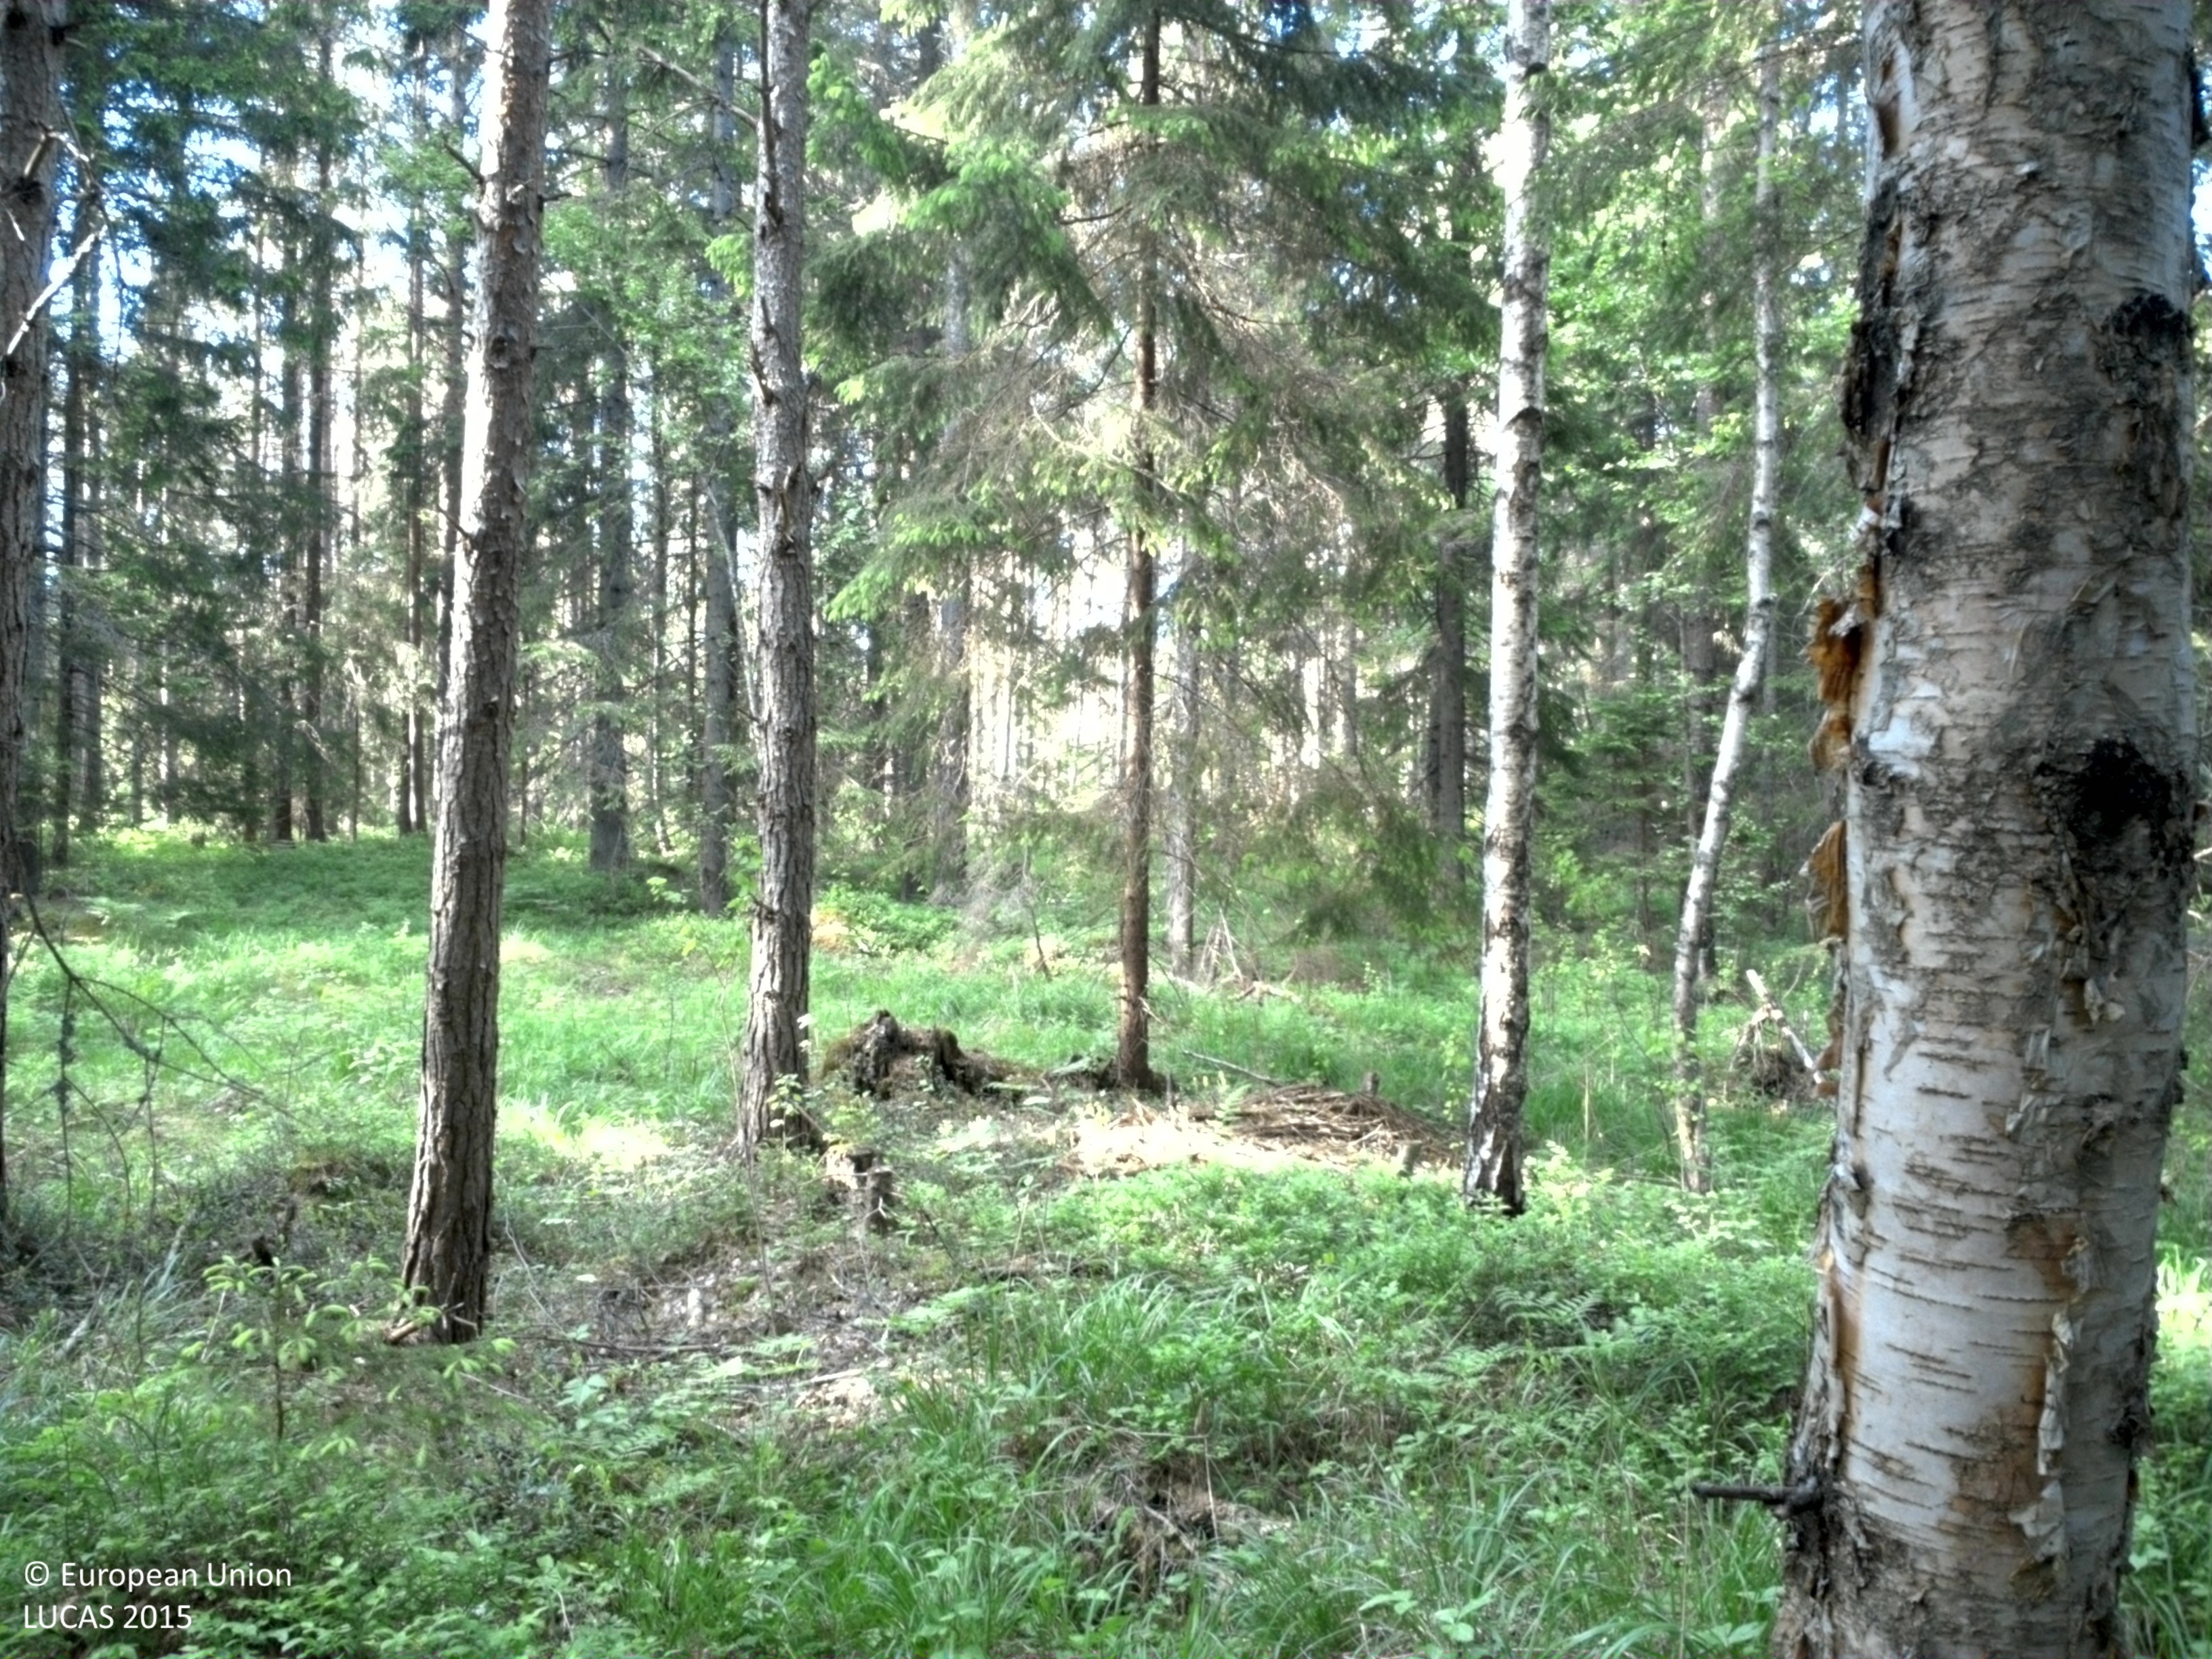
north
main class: Woodland
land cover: Pine dominated coniferous woodland
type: boreal forest
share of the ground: > 75 %
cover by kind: coniferous forest trees 85 %, broadleaved forest trees 5 %, herbaceous plants 5 %, lichens and mosses 5 %
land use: Forestry
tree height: > 5 m
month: June
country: SE
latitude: 60.0115
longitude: 18.8422
